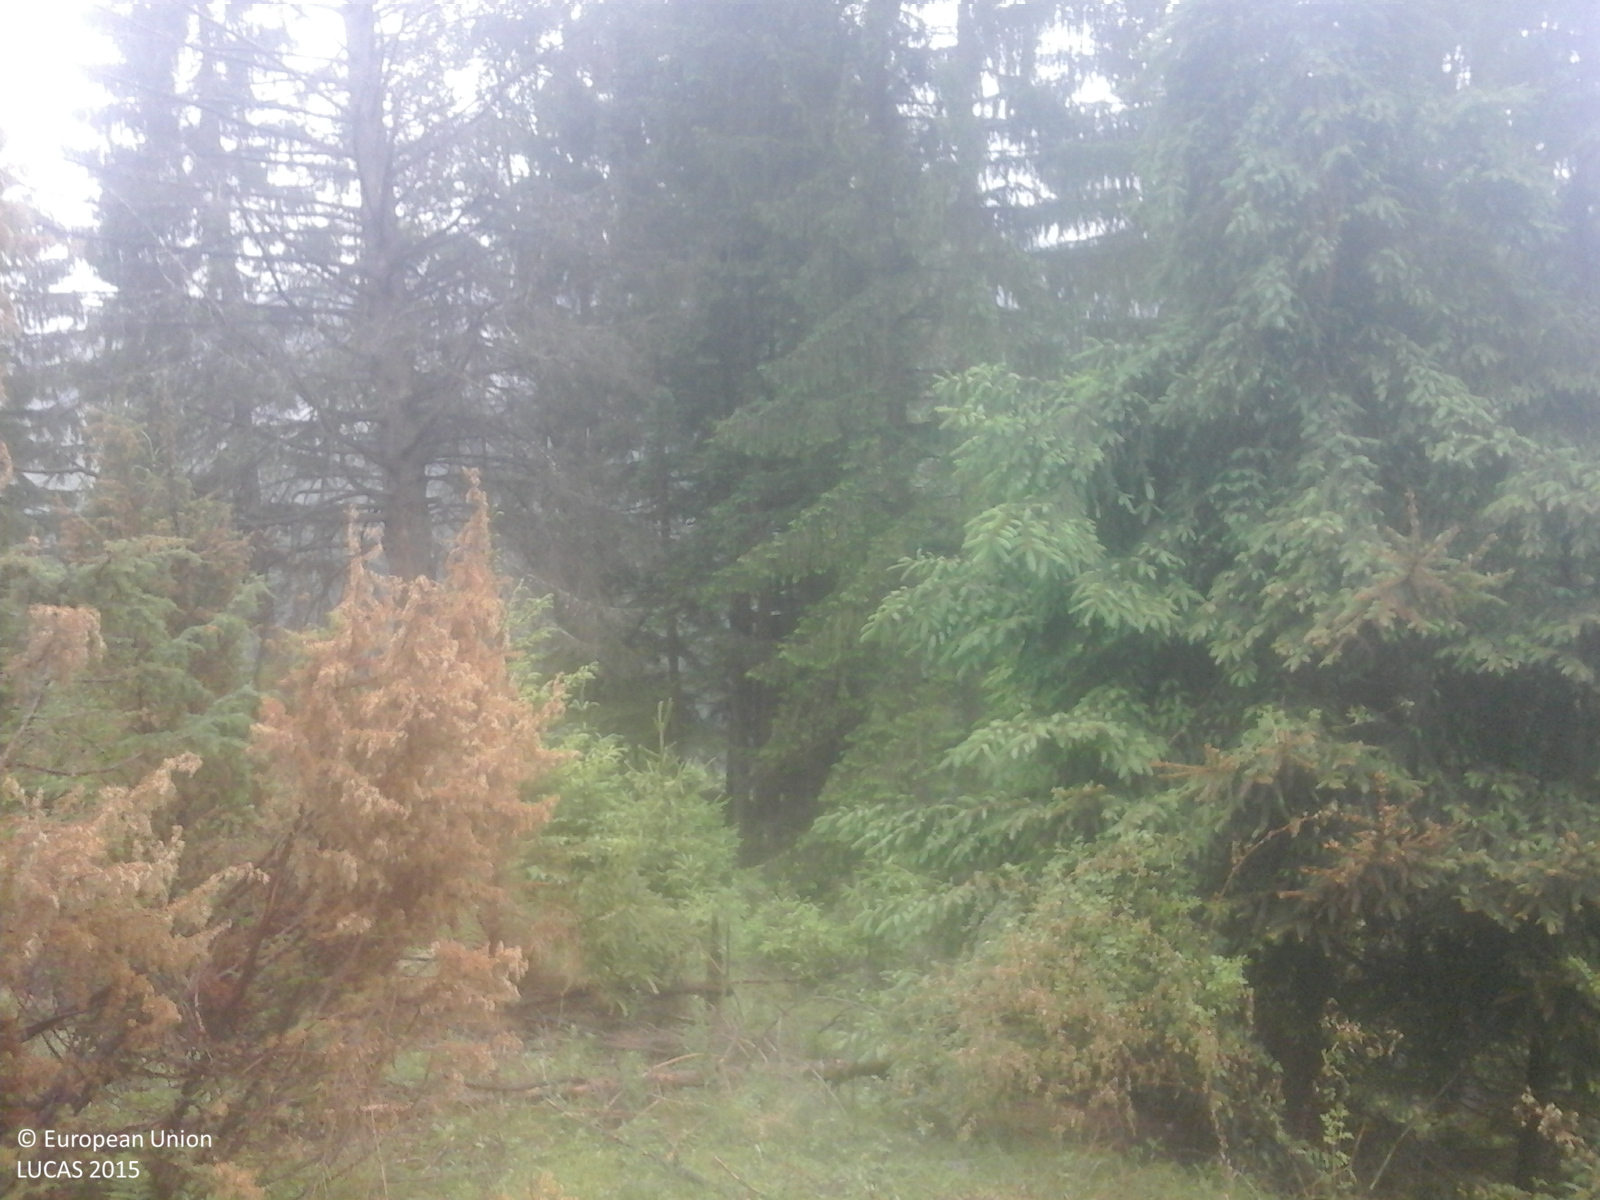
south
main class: Woodland
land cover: Spruce dominated coniferous woodland
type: alpine coniferous forest
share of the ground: > 75 %
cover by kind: coniferous forest trees 80 %, broadleaved forest trees 20 %
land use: Forestry
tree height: > 5 m
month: June
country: RO
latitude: 47.4322
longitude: 25.8621
